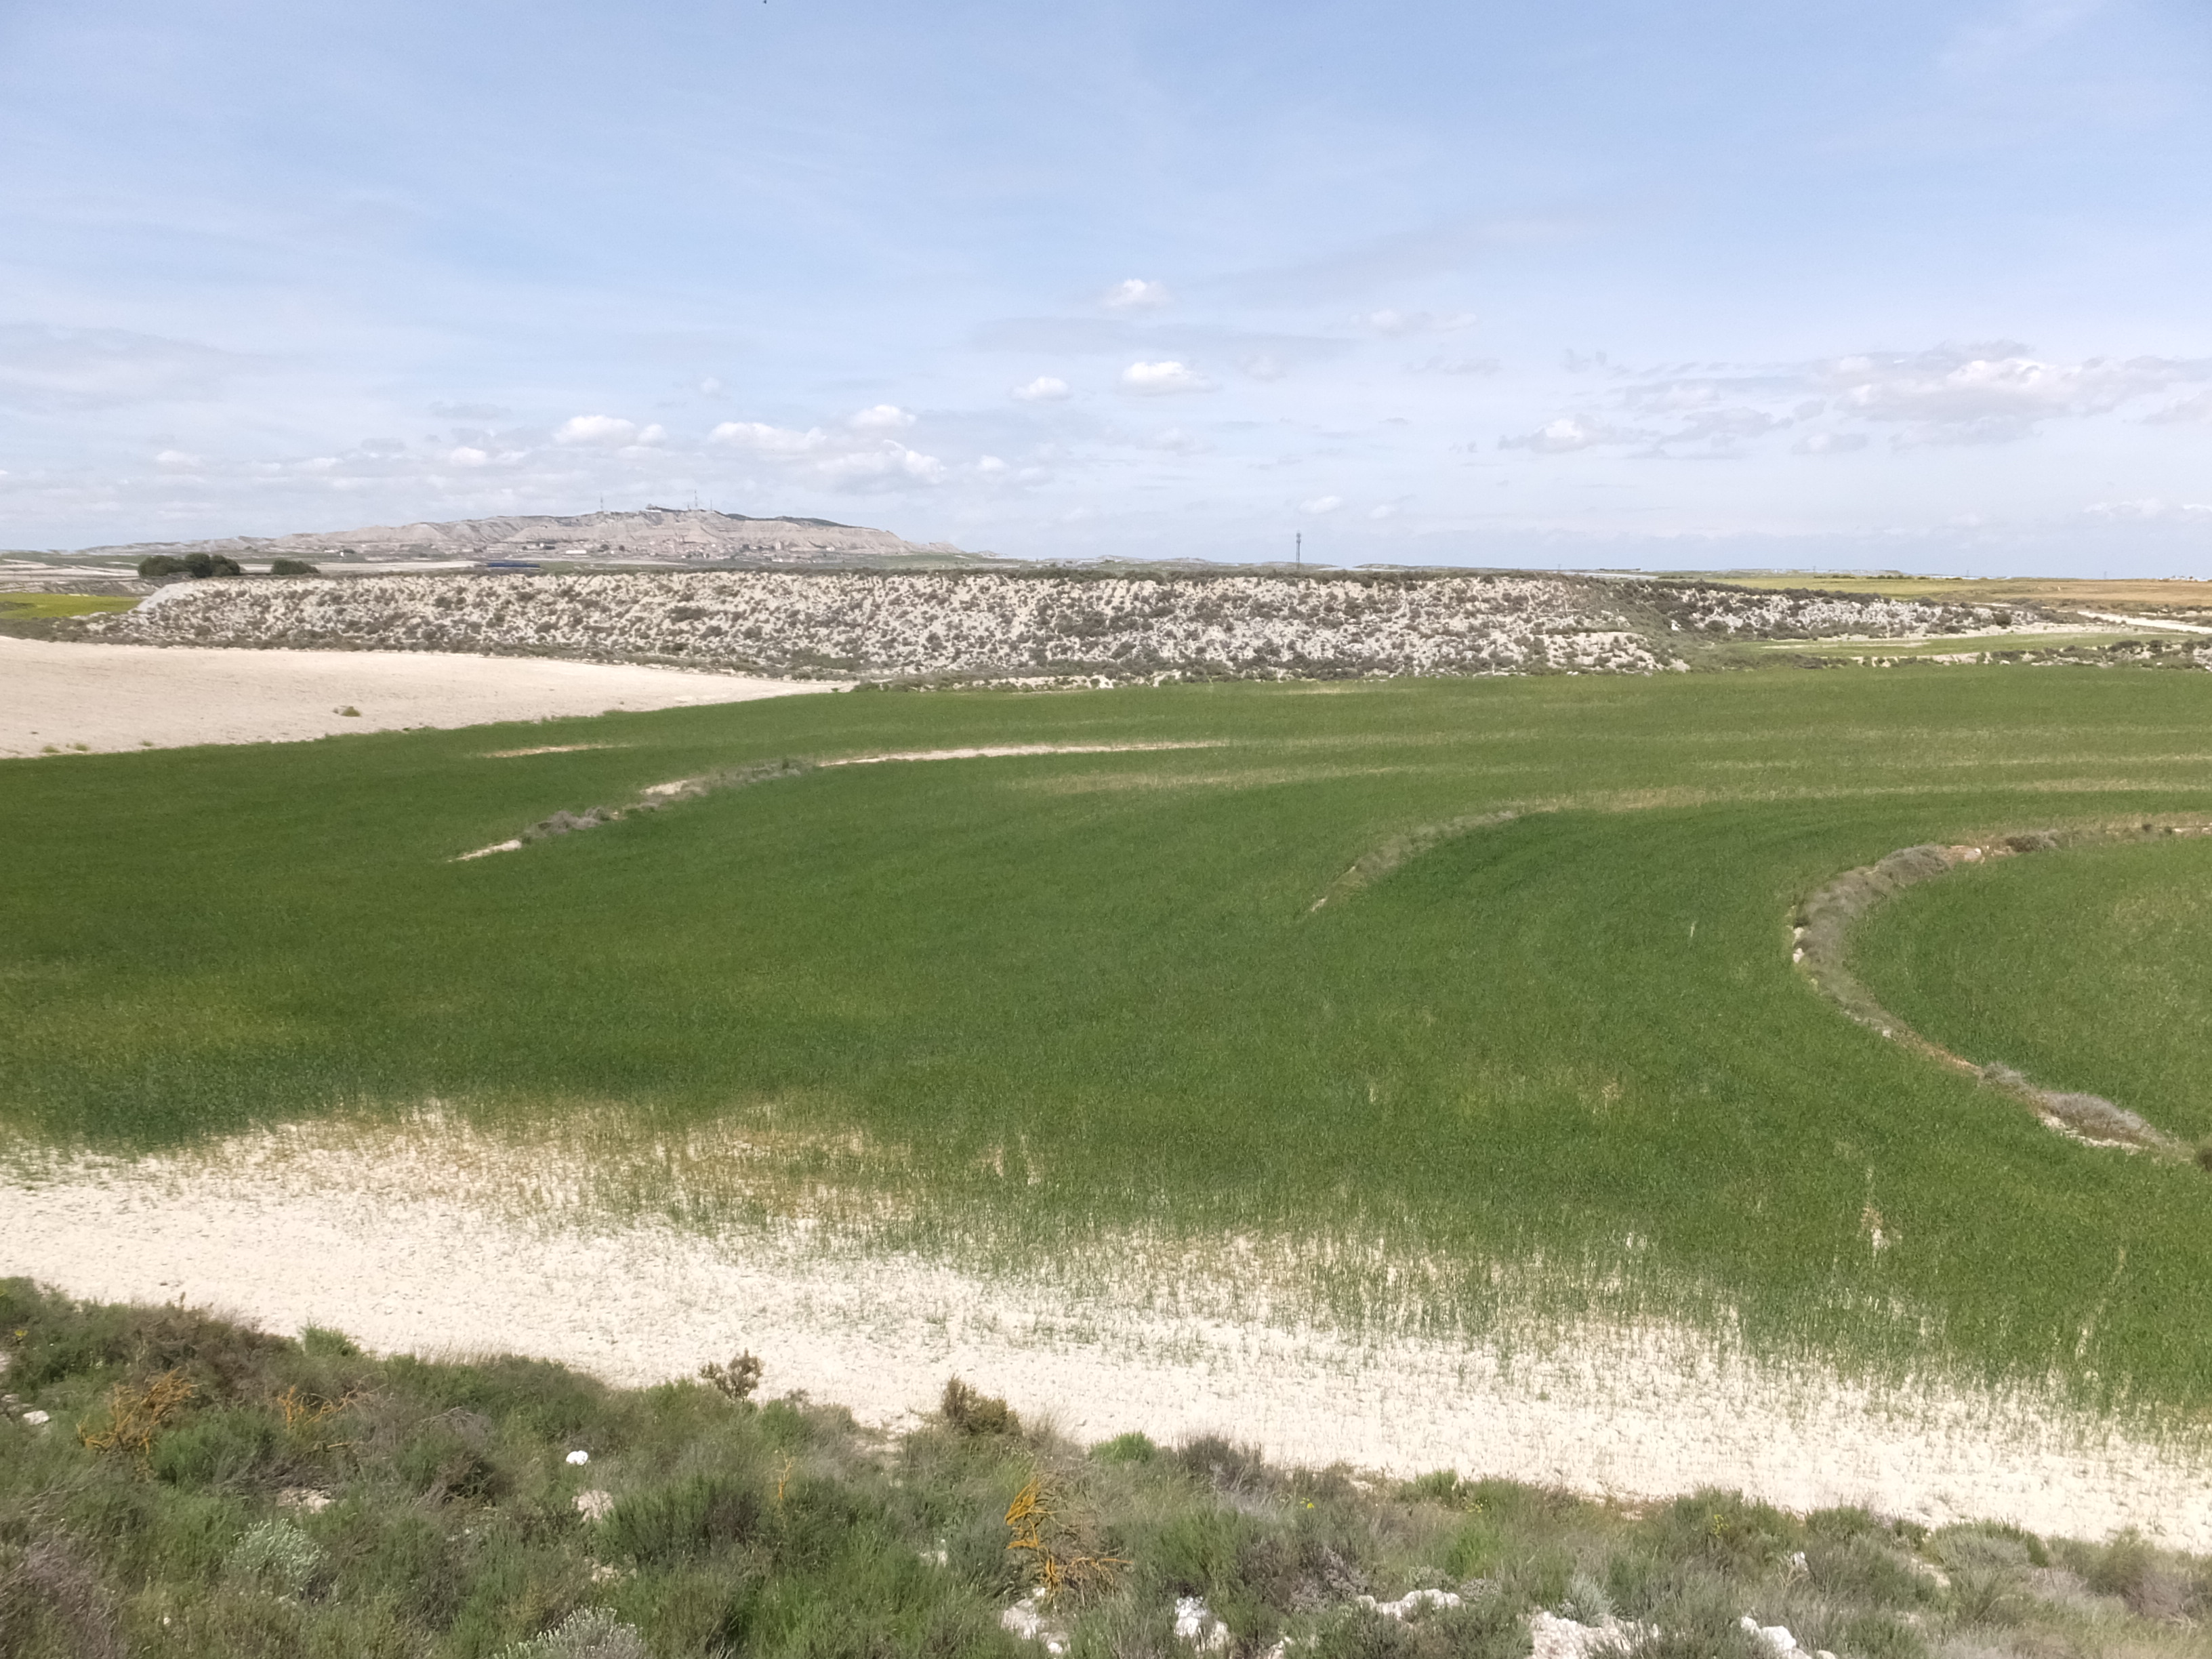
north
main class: Shrubland
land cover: Shrubland without tree cover
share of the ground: > 75 %
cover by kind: shrubs 100 %
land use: Semi-natural and natural areas not in use
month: April
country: ES
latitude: 41.5202
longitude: -0.1896
